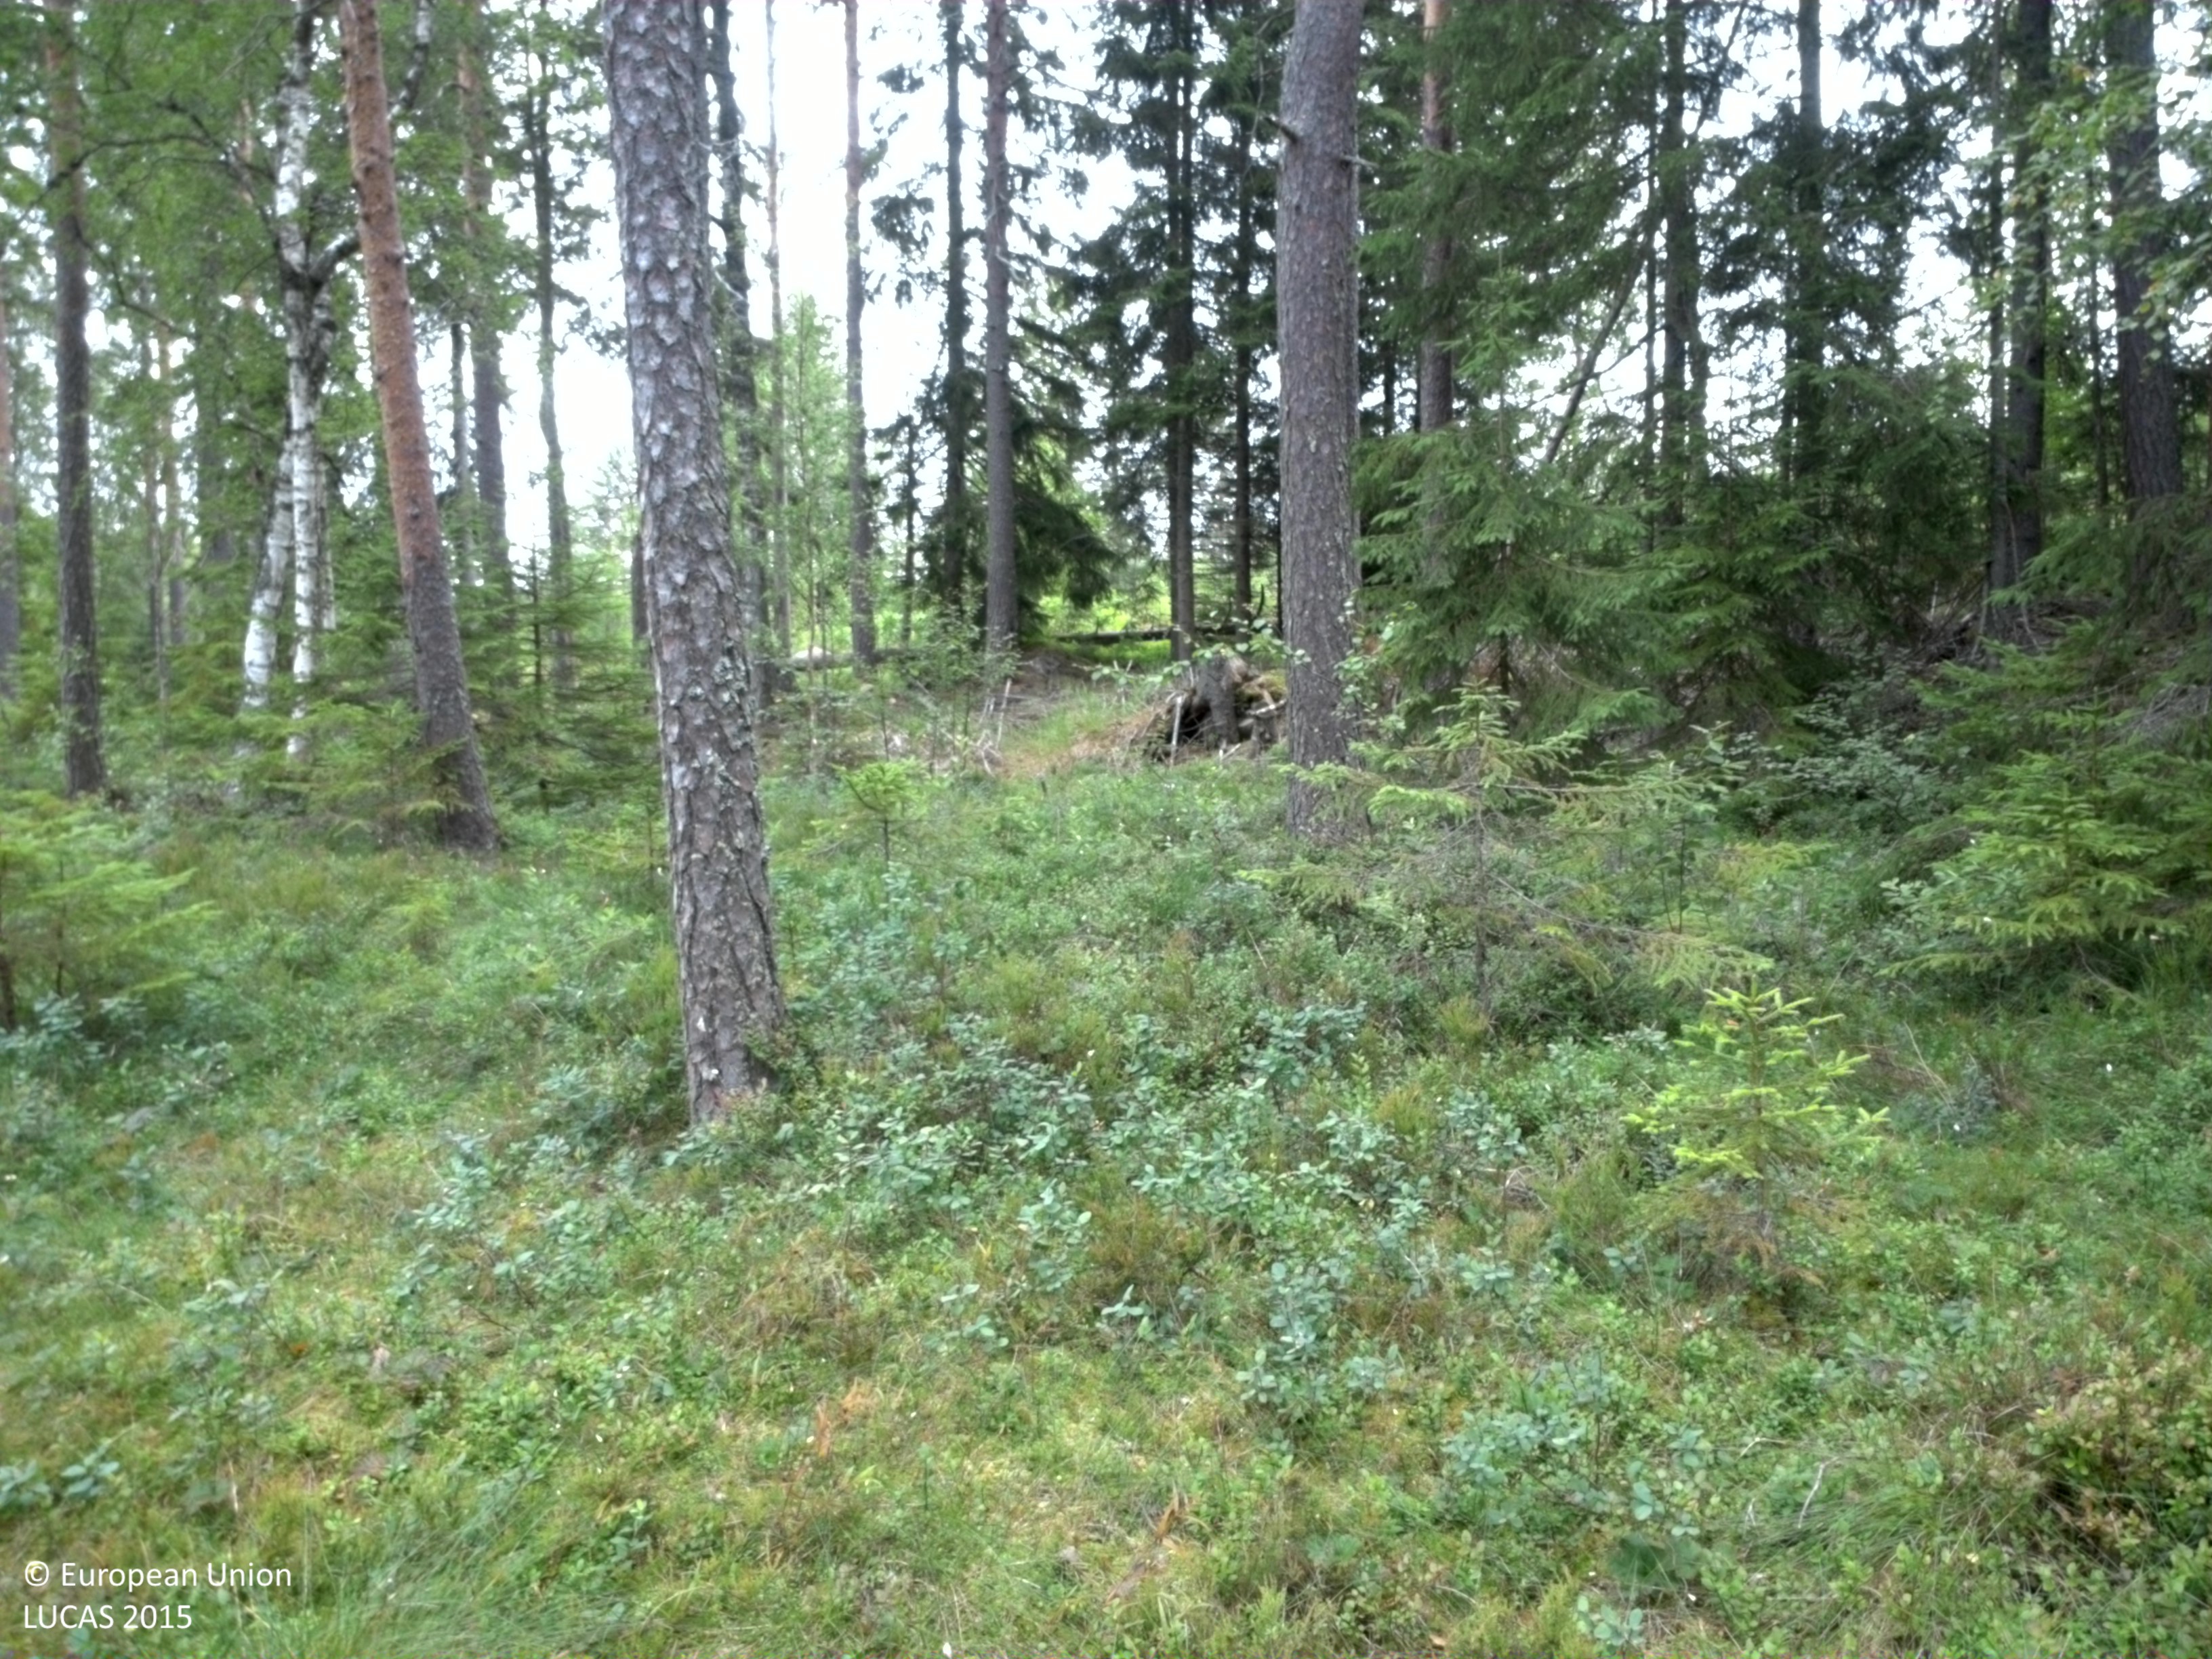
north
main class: Woodland
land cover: Pine dominated coniferous woodland
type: boreal forest
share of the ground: 25 - 50 %
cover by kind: coniferous forest trees 45 %, lichens and mosses 25 %, herbaceous plants 15 %, shrubs 10 %, broadleaved forest trees 5 %
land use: Forestry
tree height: > 5 m
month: August
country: SE
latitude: 60.3520
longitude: 13.5602
